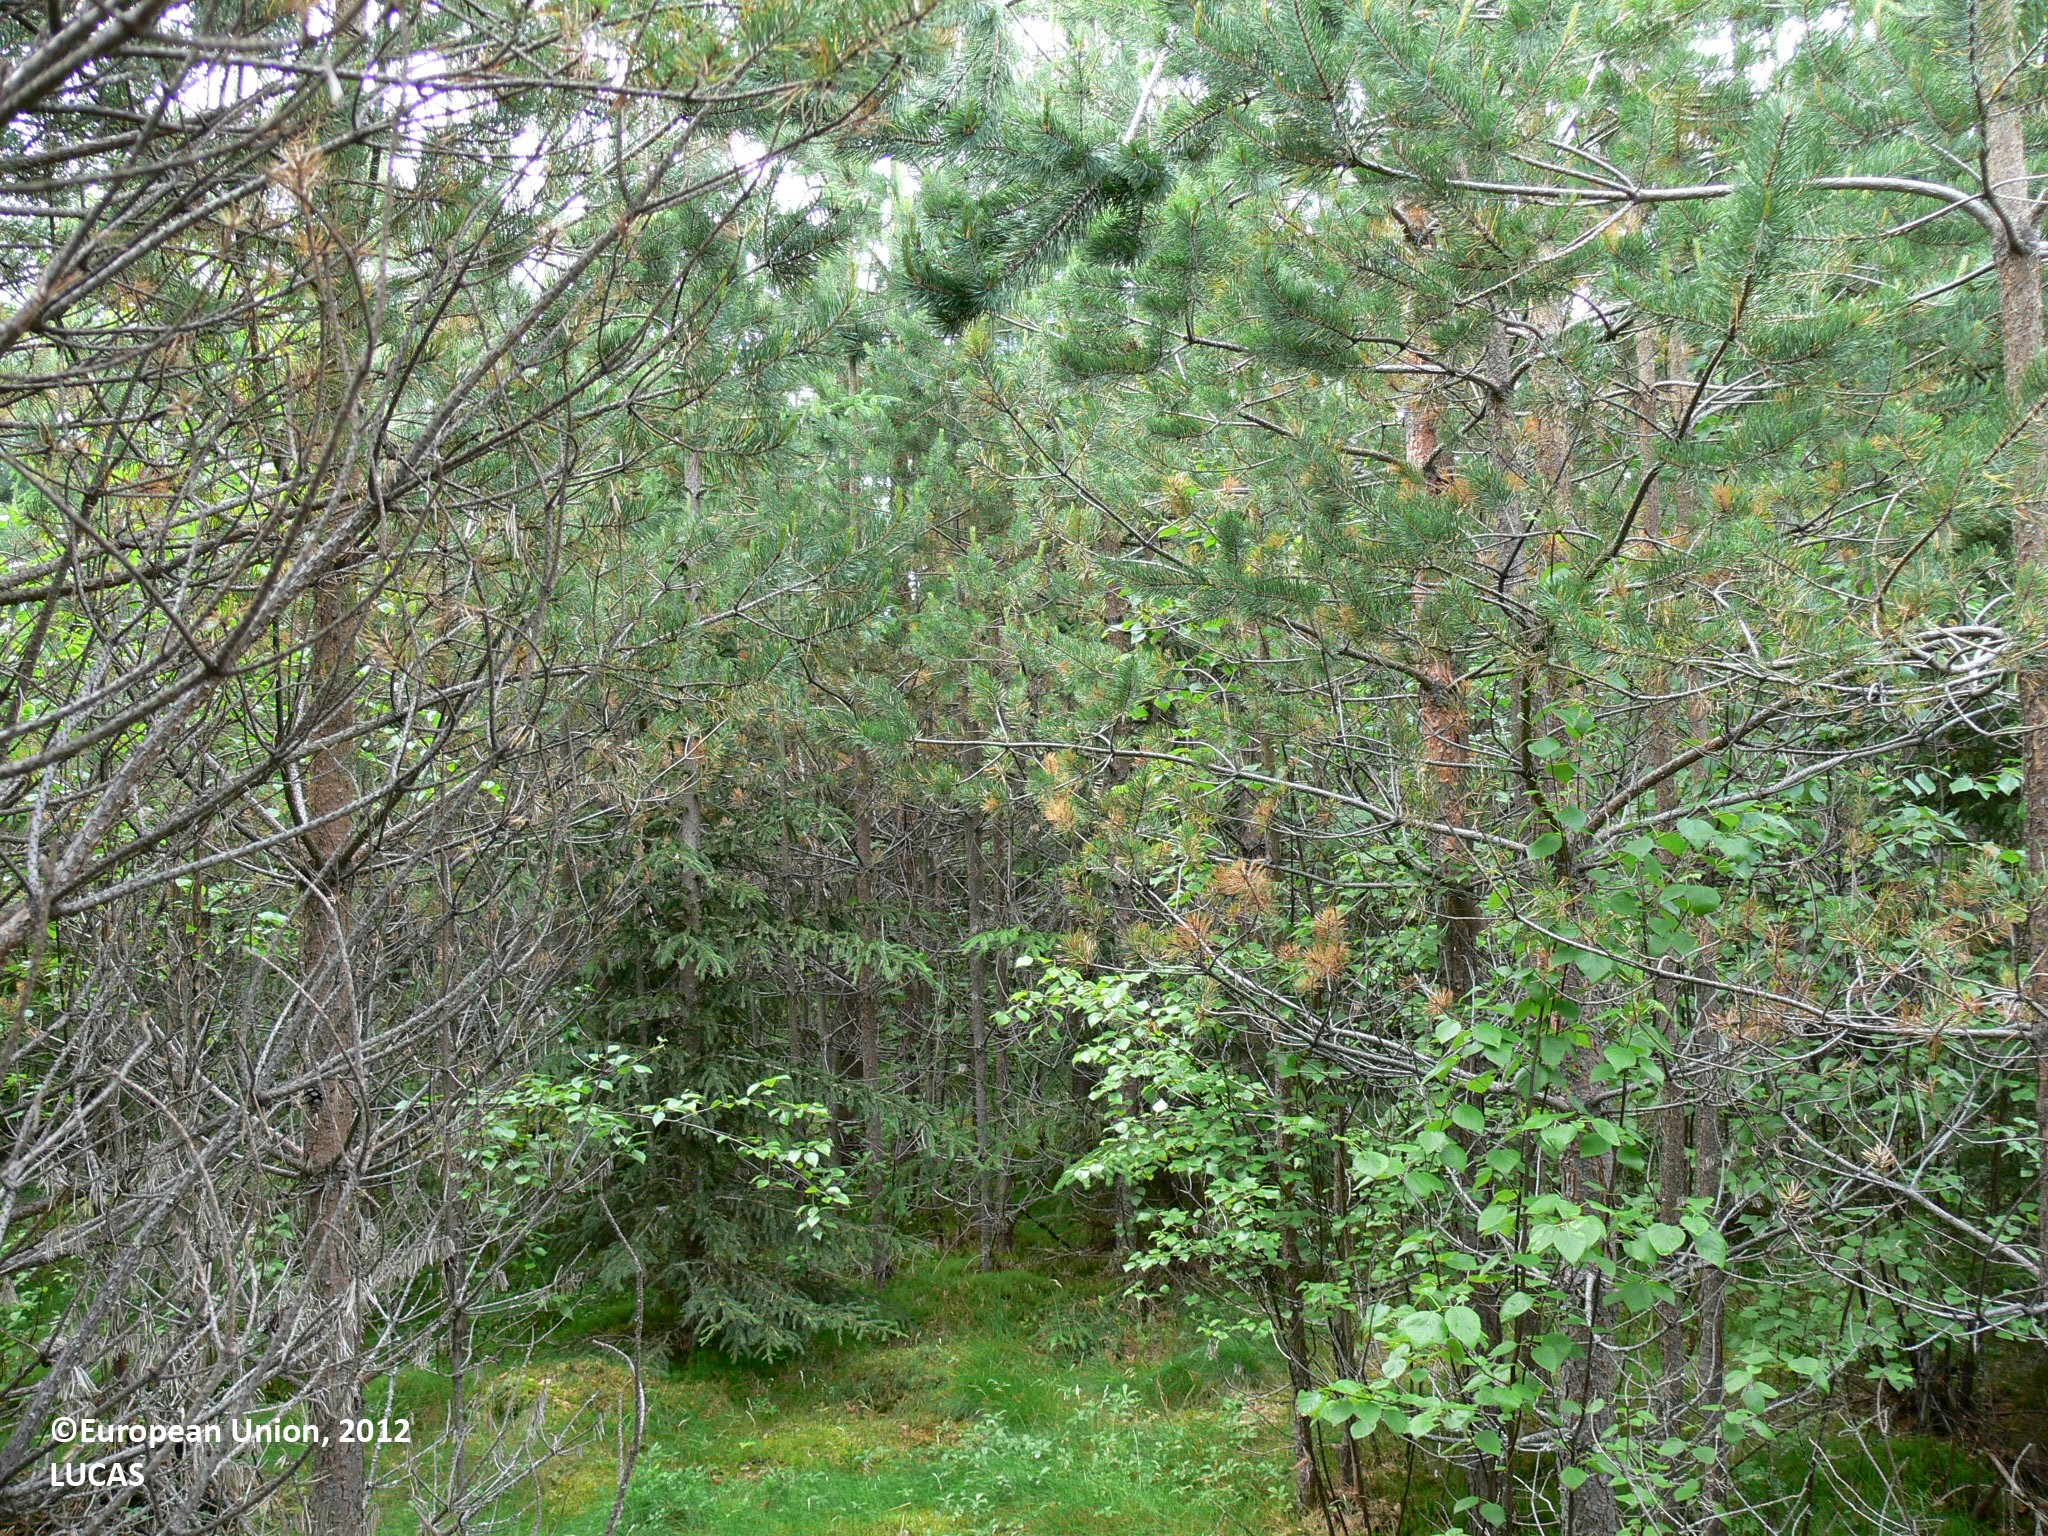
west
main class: Woodland
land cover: Other coniferous woodland
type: boreal forest
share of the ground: > 75 %
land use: Forestry
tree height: < 5 m
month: June
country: FI
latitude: 62.5486
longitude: 29.5085
